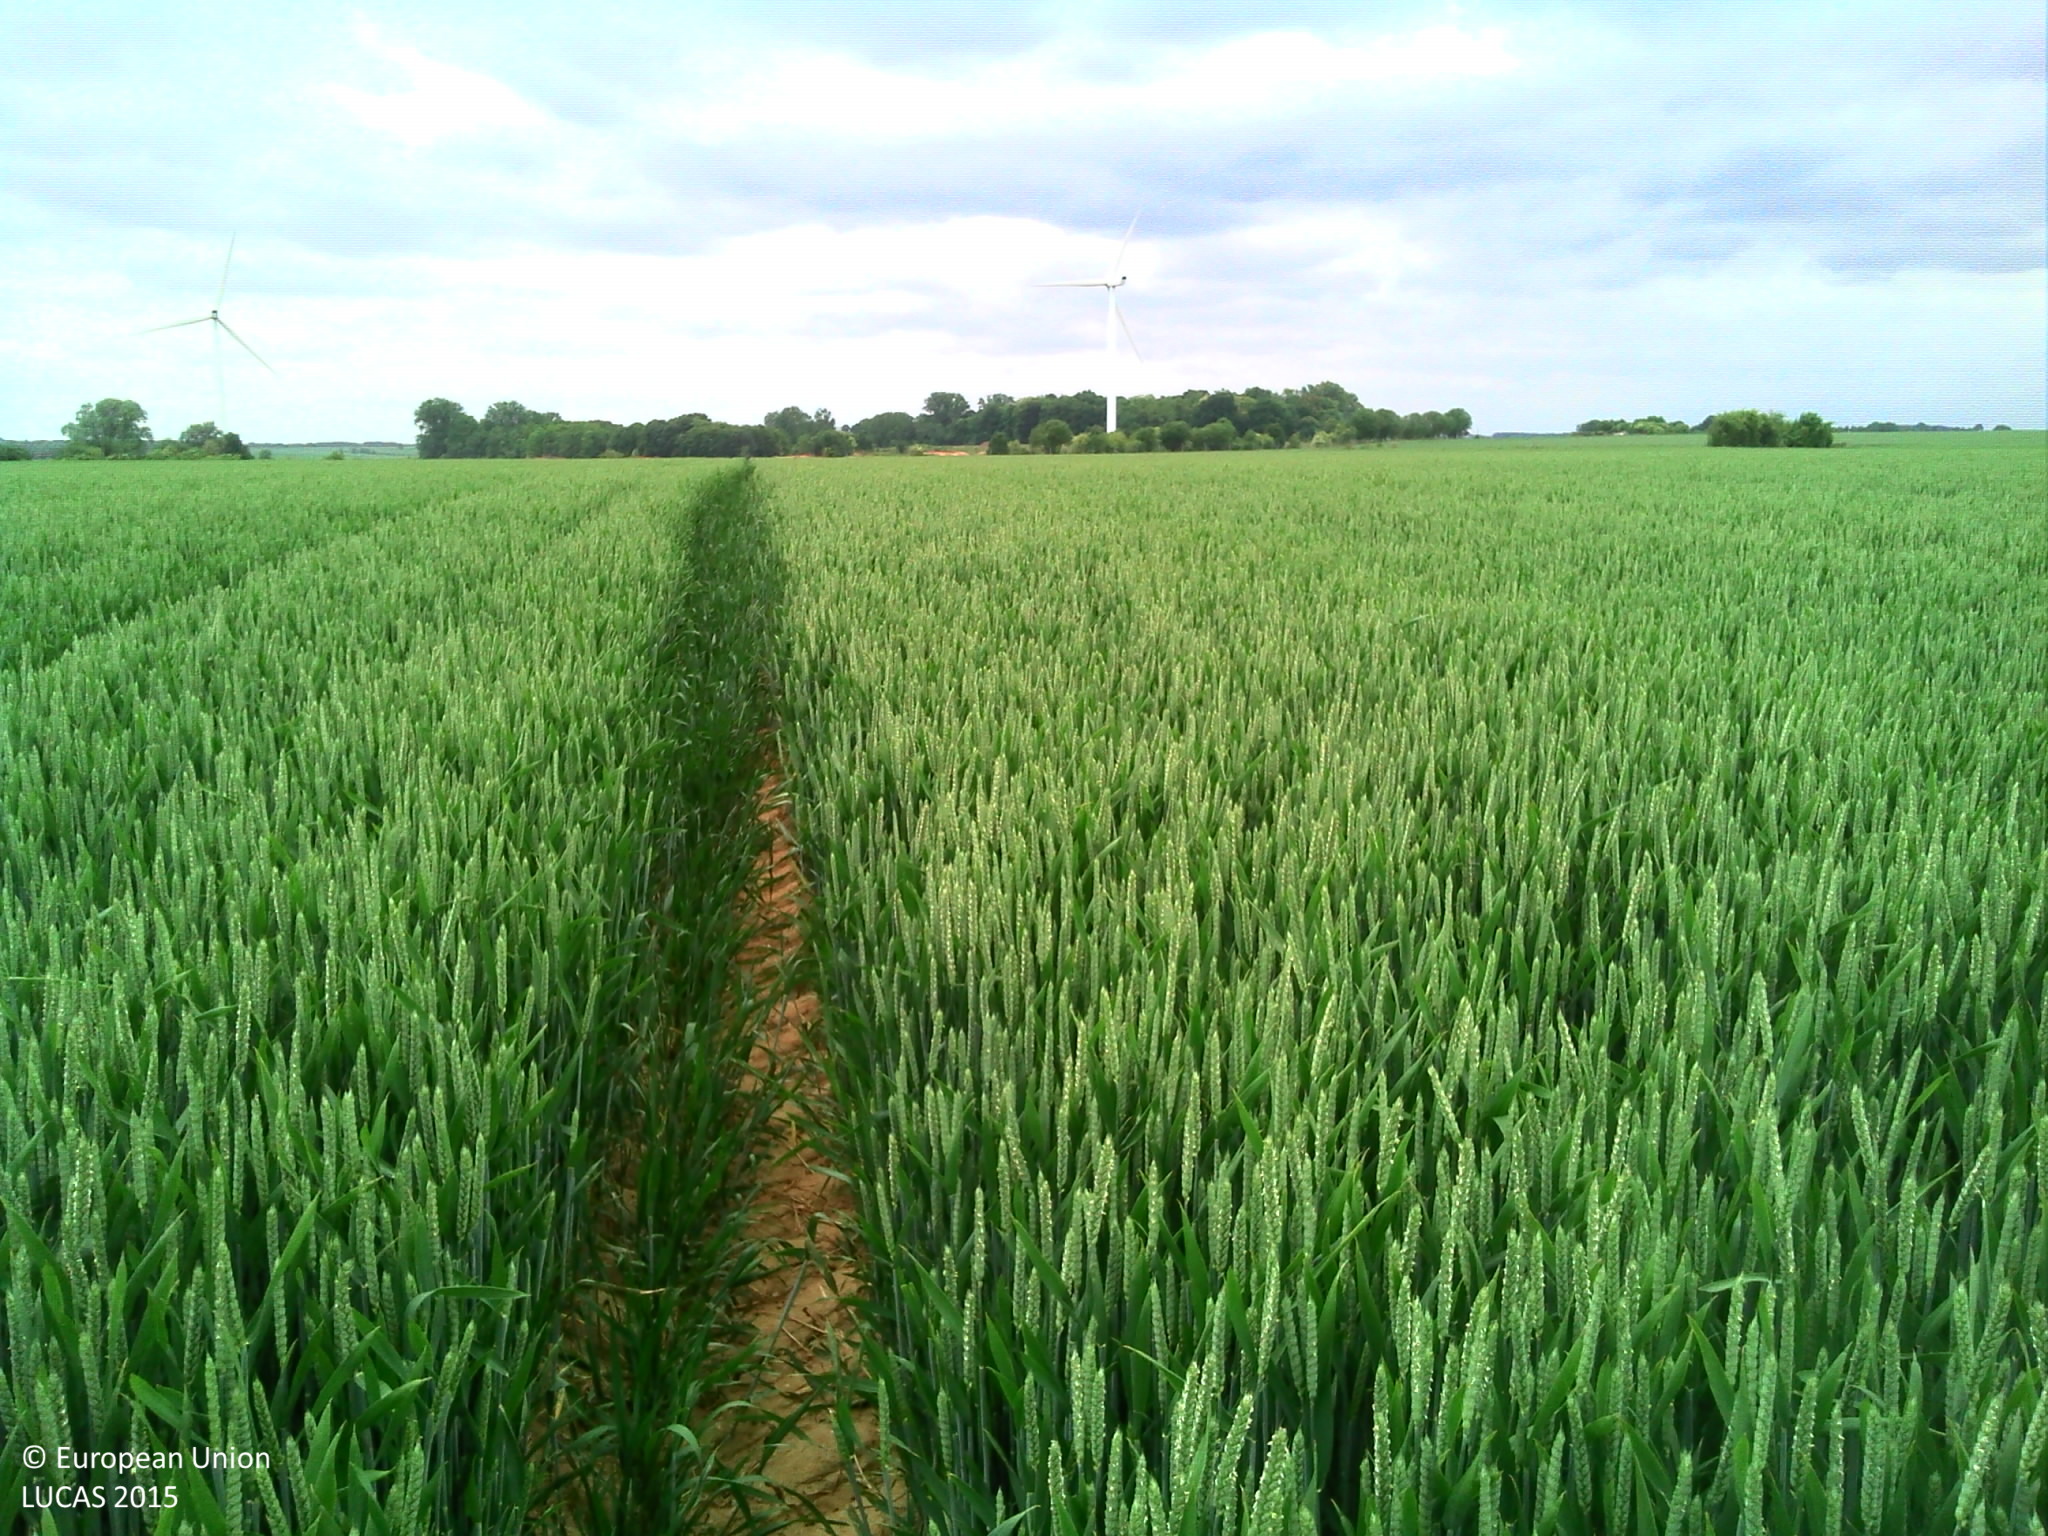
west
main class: Cropland
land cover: Common wheat
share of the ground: > 75 %
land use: Agriculture (excluding fallow land and kitchen gardens)
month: May
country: FR
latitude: 49.7664
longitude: 3.2301
